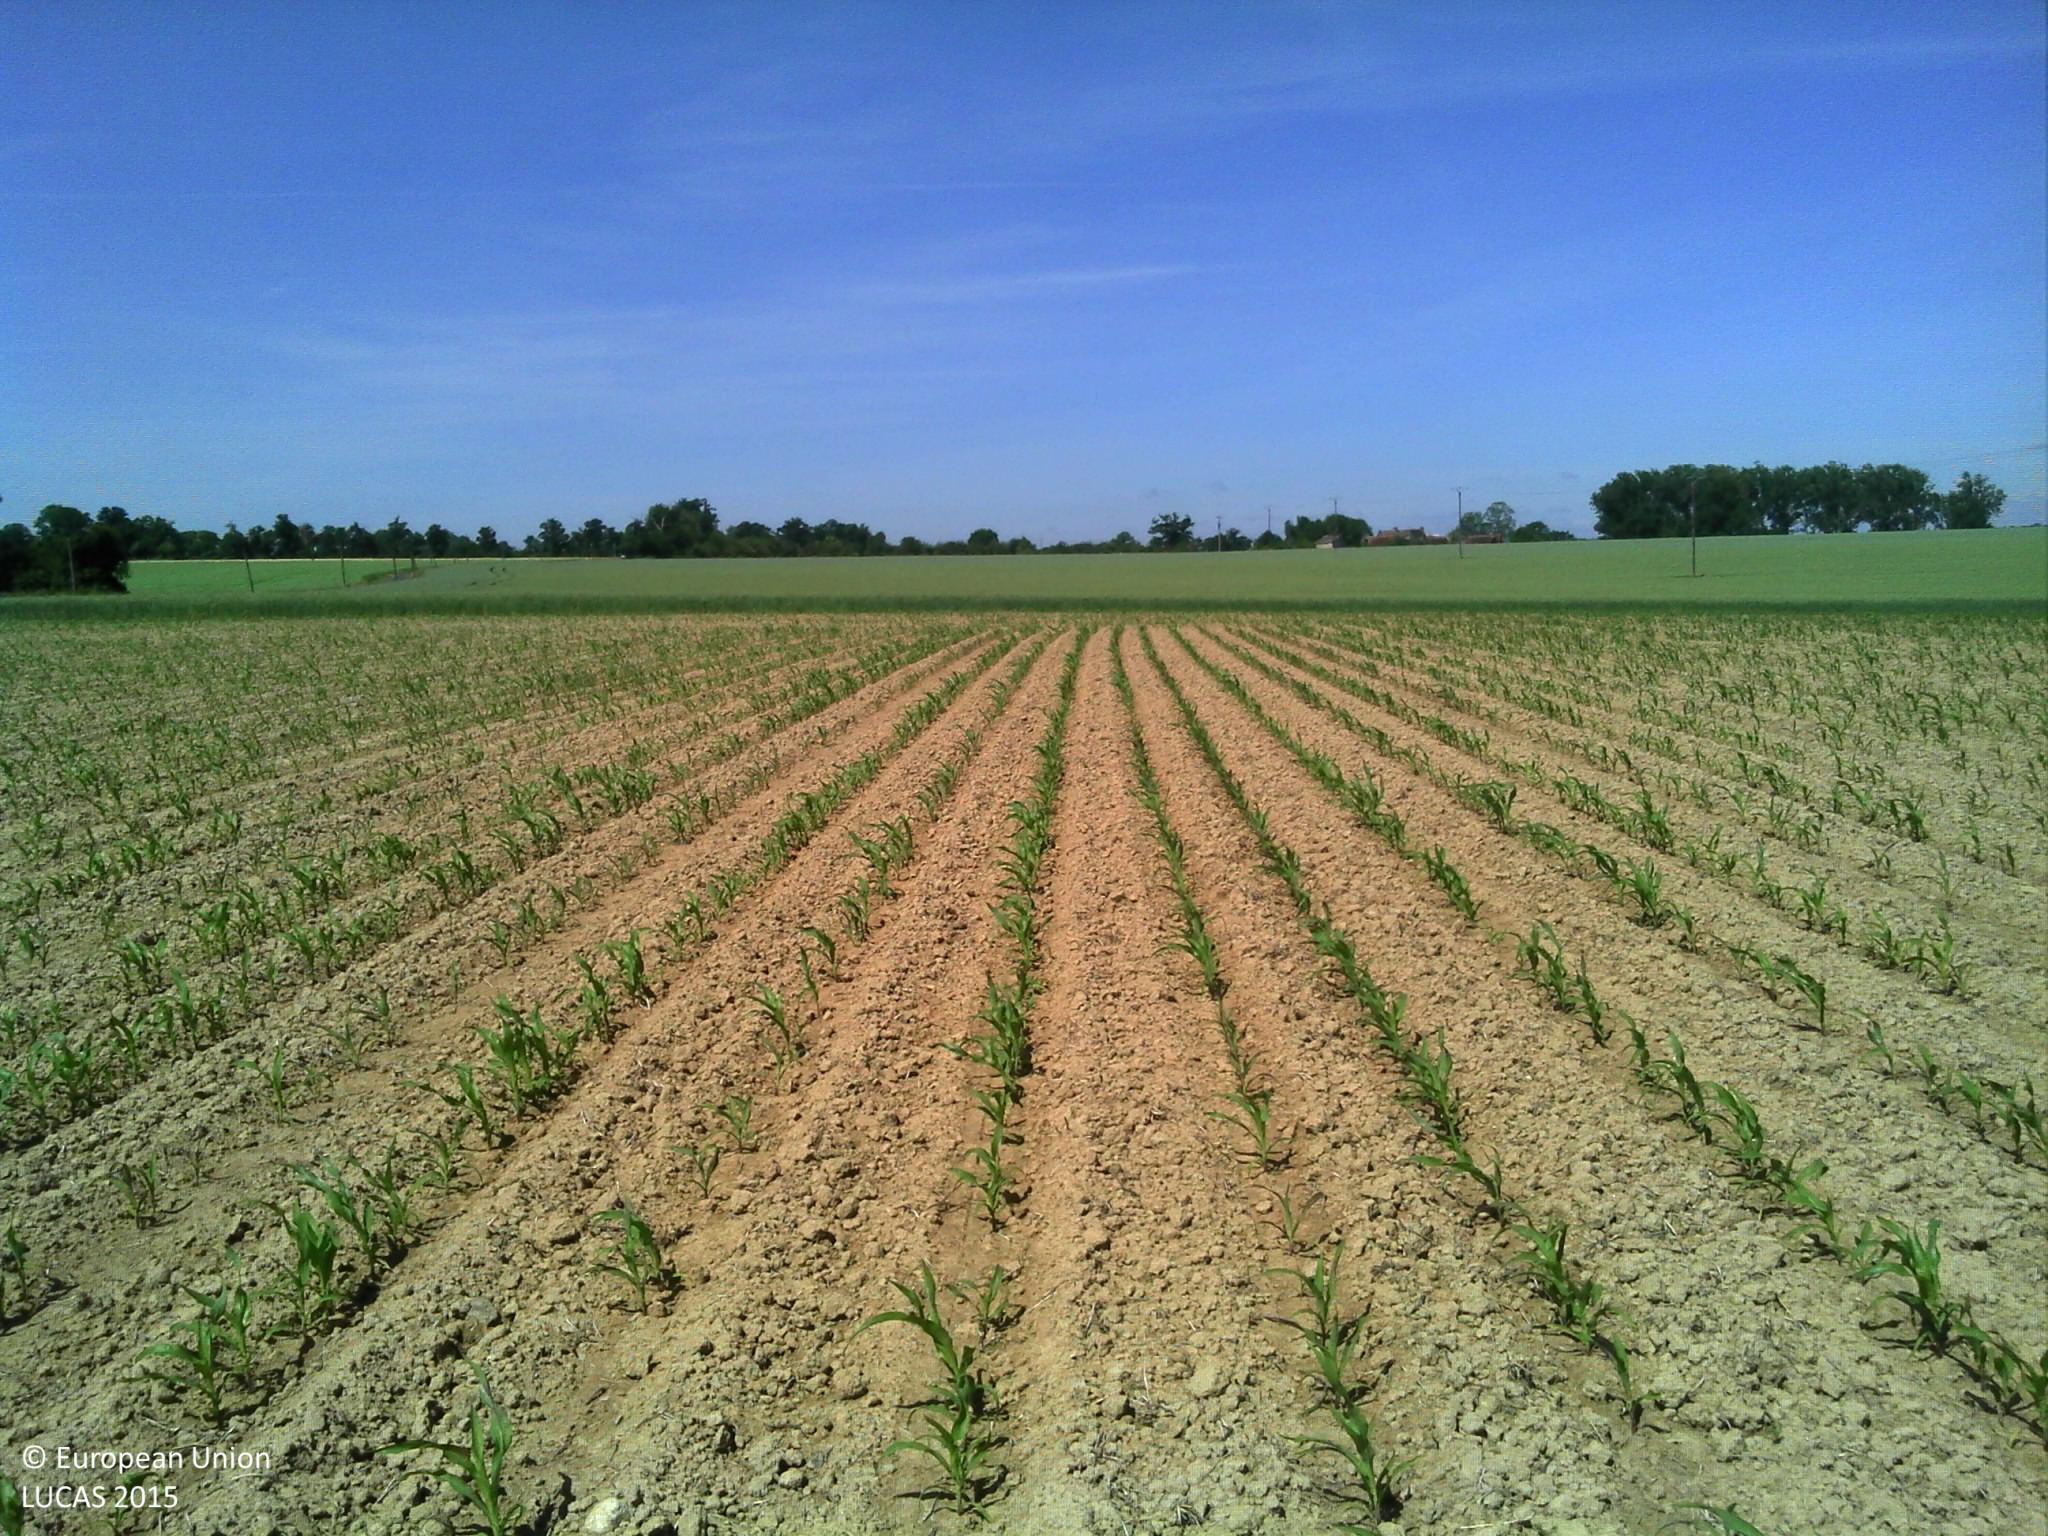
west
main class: Cropland
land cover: Maize
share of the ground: 10 - 25 %
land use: Agriculture (excluding fallow land and kitchen gardens)
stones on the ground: < 10 %
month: June
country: FR
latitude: 48.6228
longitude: -0.1658
